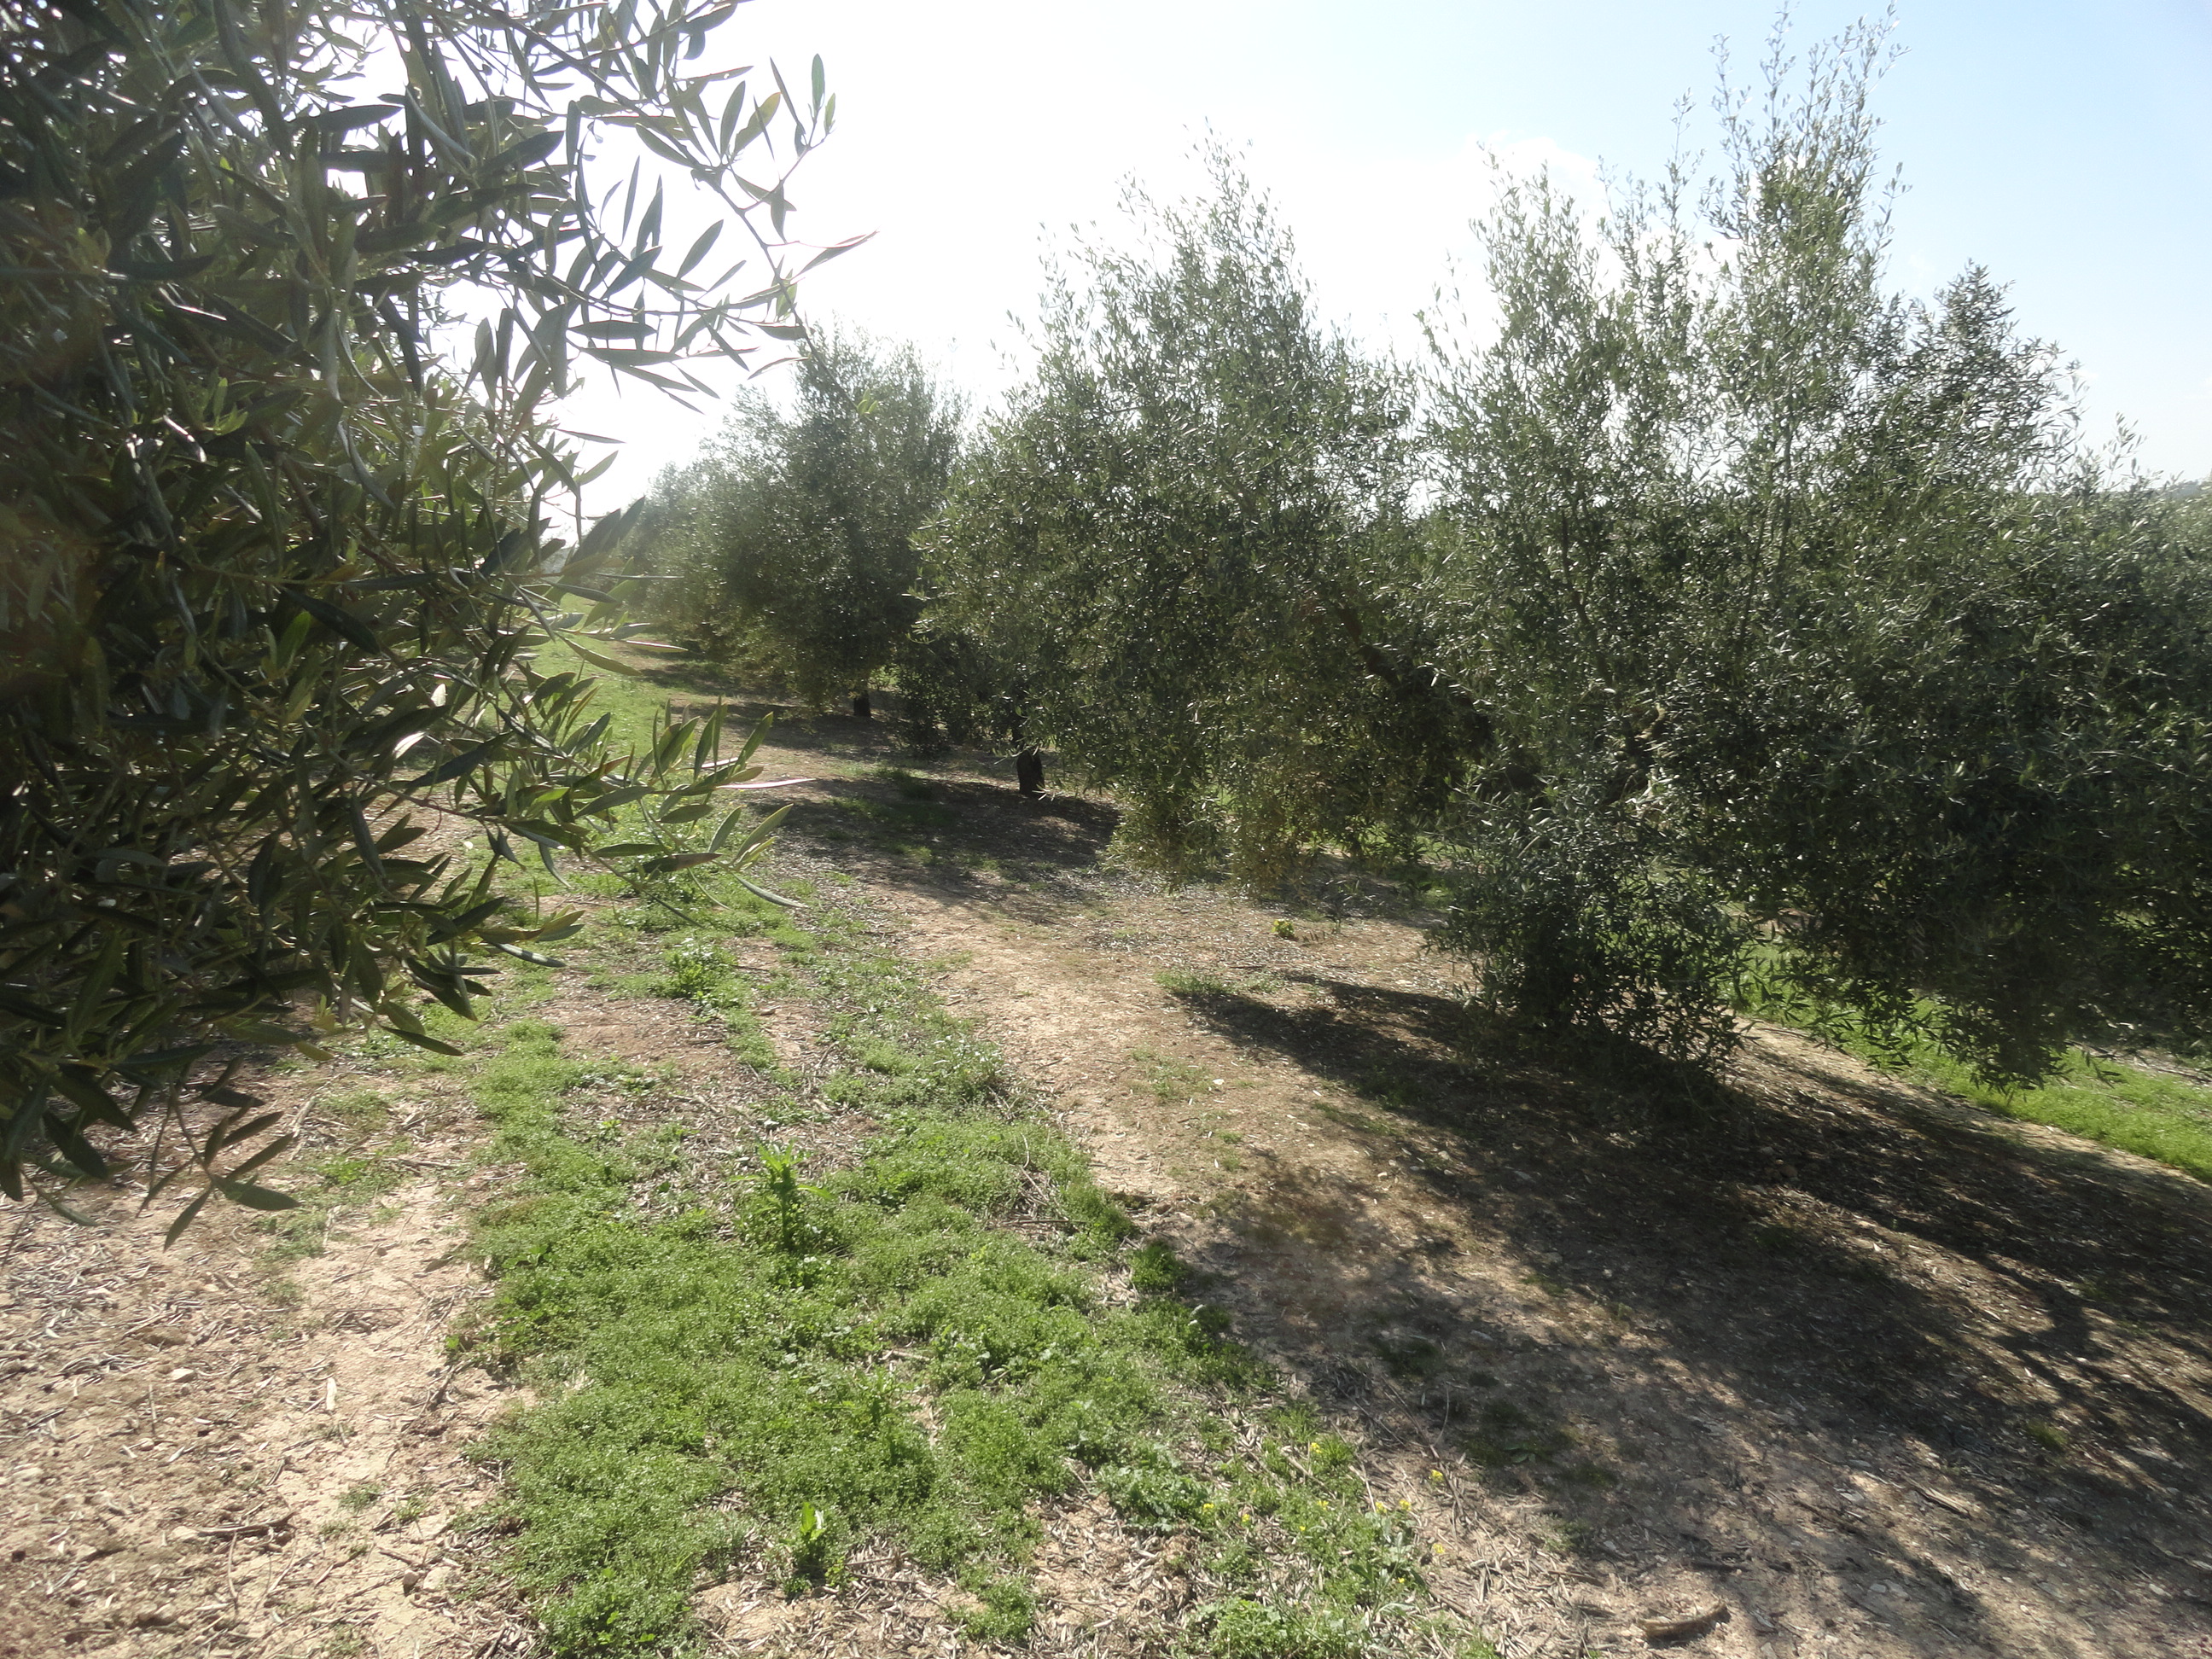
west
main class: Cropland
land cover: Olive groves
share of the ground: 50 - 75 %
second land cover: Spontaneously vegetated surfaces
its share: 25 - 50 %
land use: Agriculture (excluding fallow land and kitchen gardens)
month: April
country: ES
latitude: 37.5129
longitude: -4.4970
